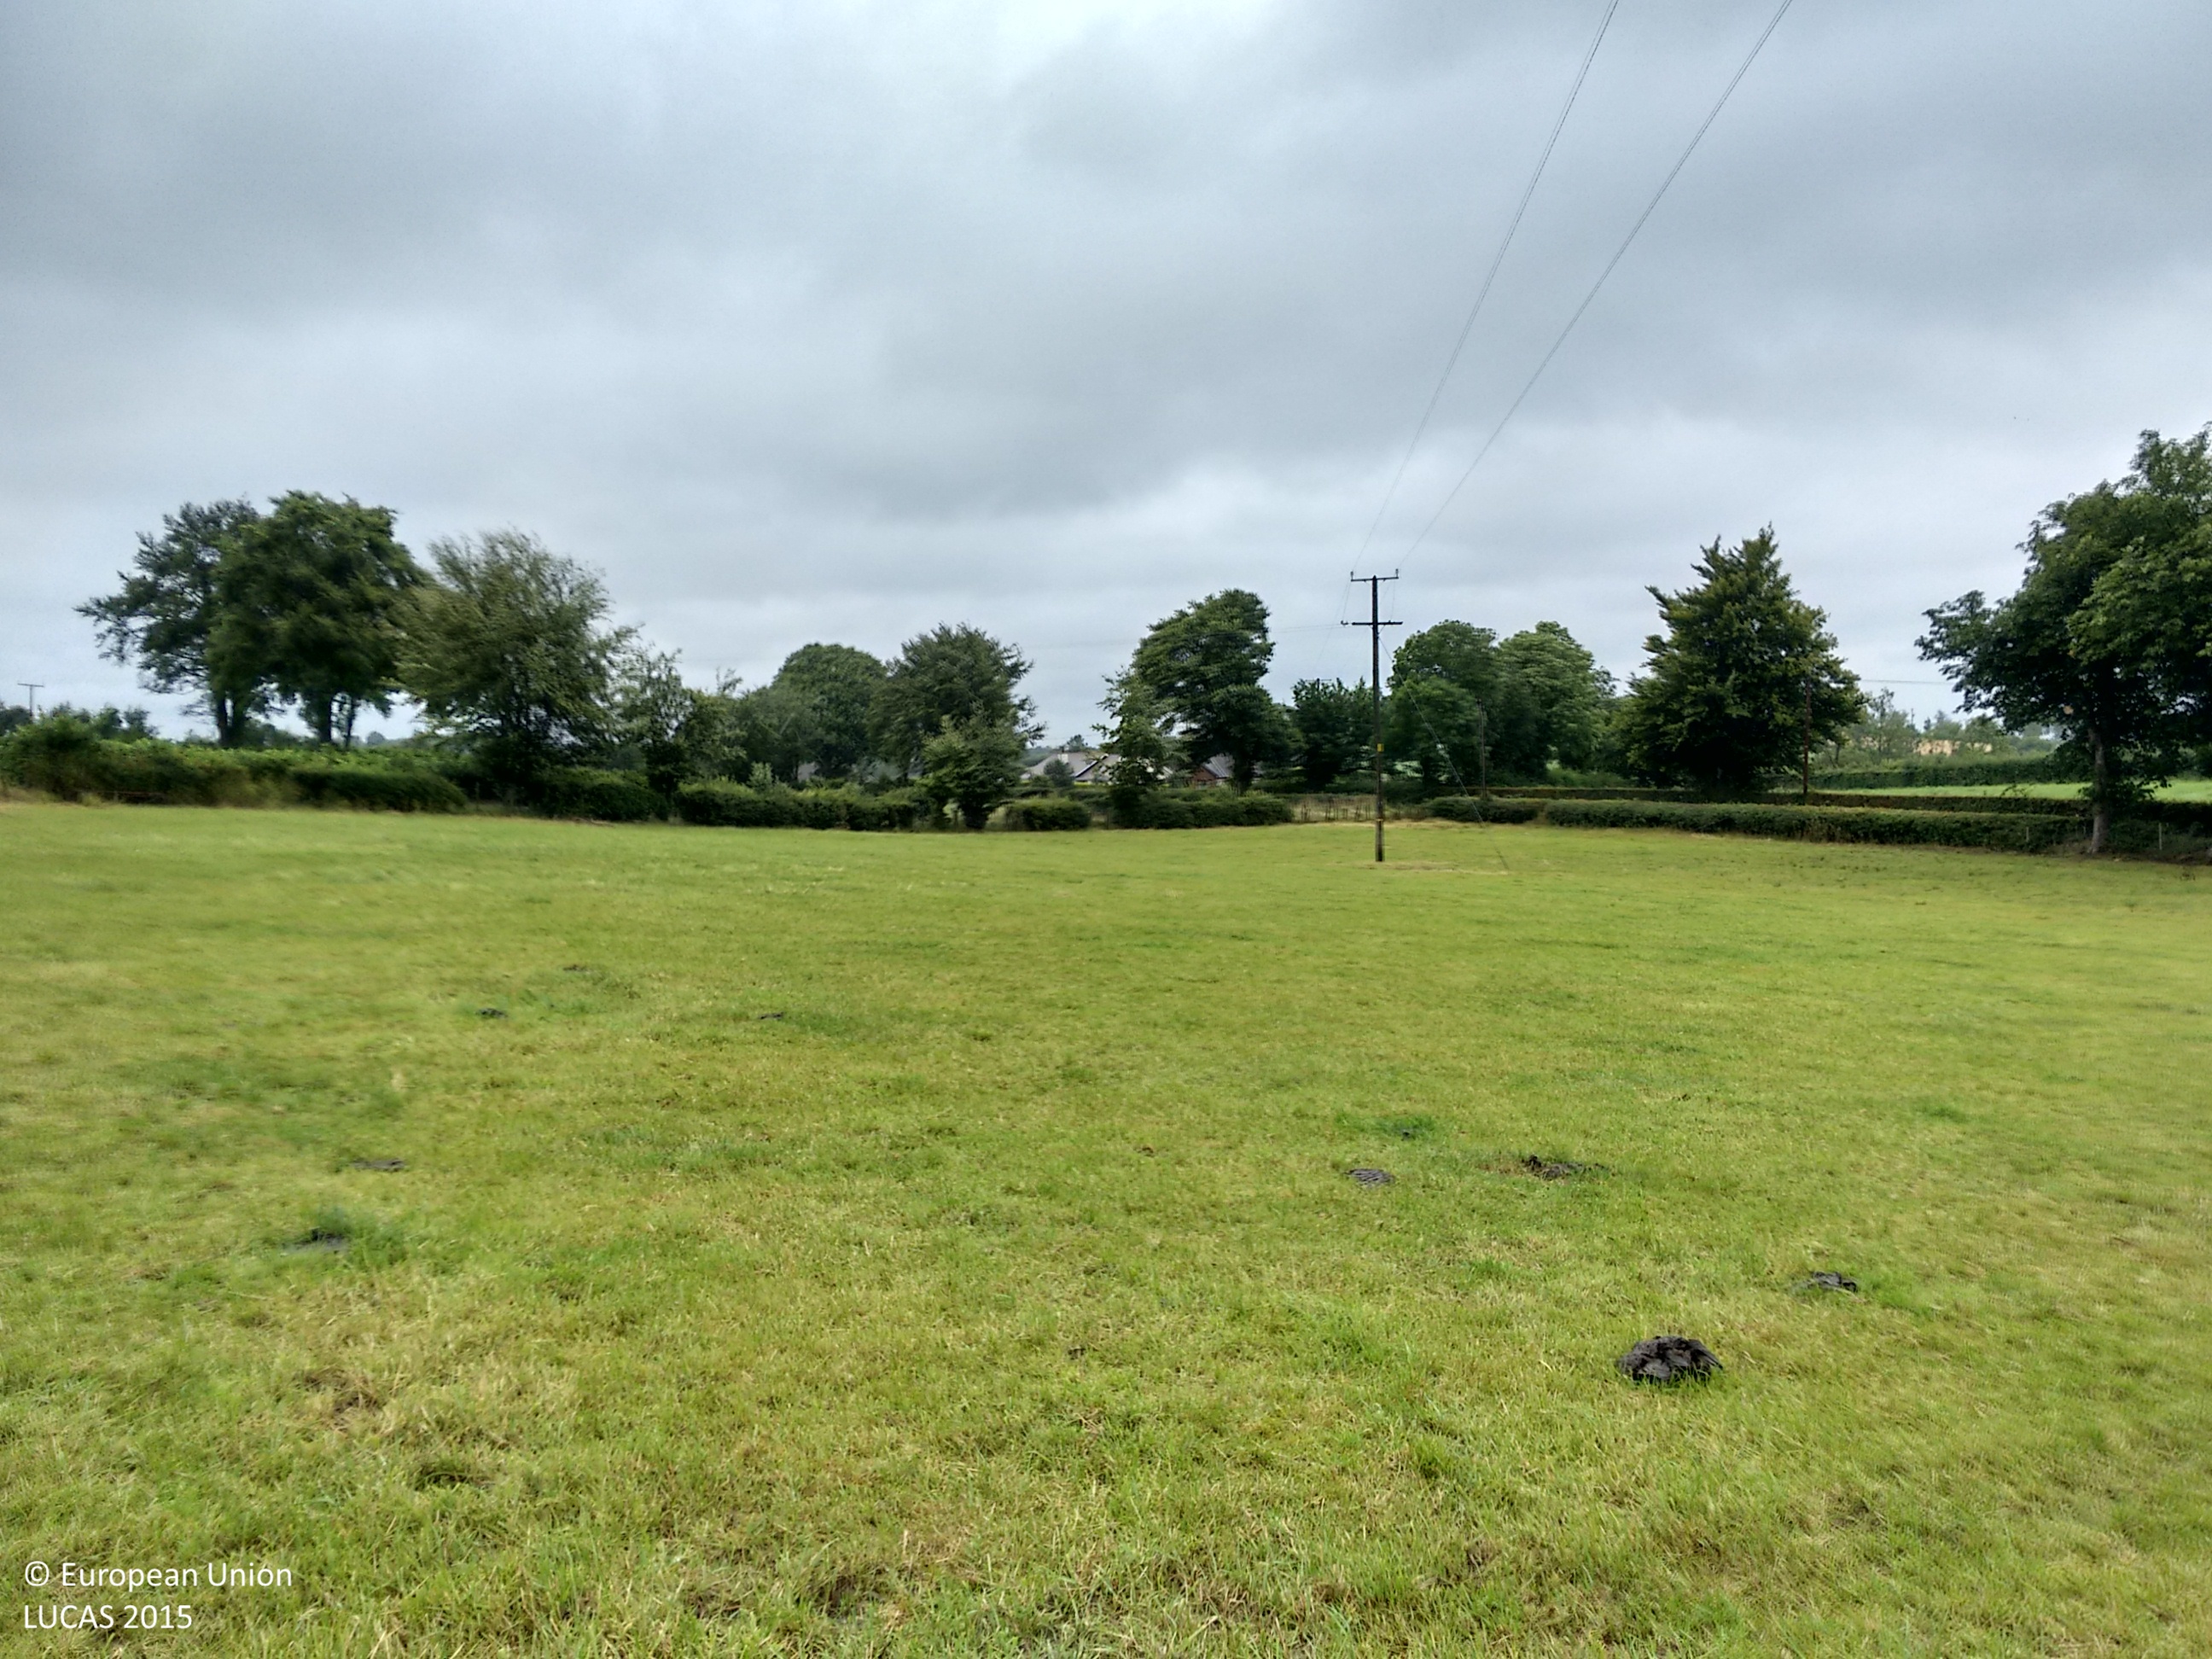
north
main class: Grassland
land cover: Grassland without tree/shrub cover
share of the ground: > 75 %
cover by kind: herbaceous plants 100 %
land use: Agriculture (excluding fallow land and kitchen gardens)
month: August
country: GB
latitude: 54.6785
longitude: -6.5493
